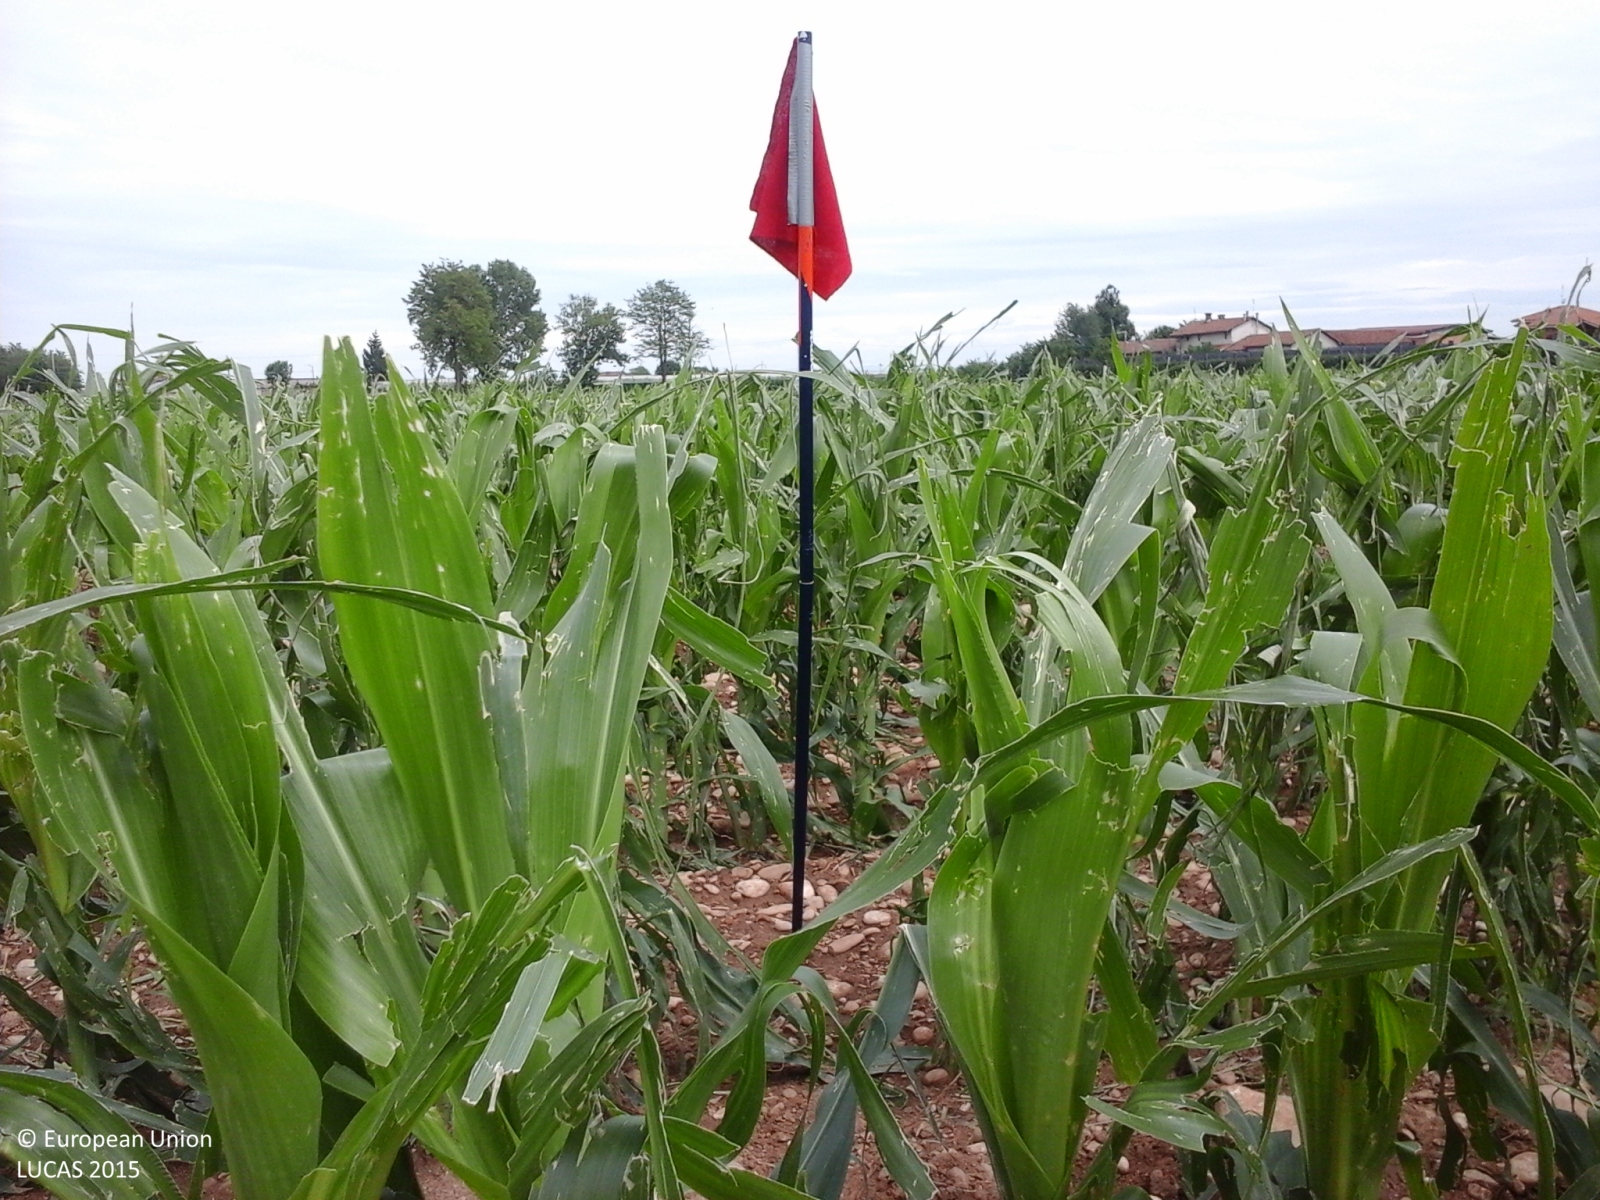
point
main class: Cropland
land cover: Maize
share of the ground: 25 - 50 %
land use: Agriculture (excluding fallow land and kitchen gardens)
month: May
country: IT
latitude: 44.5044
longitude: 7.6527
